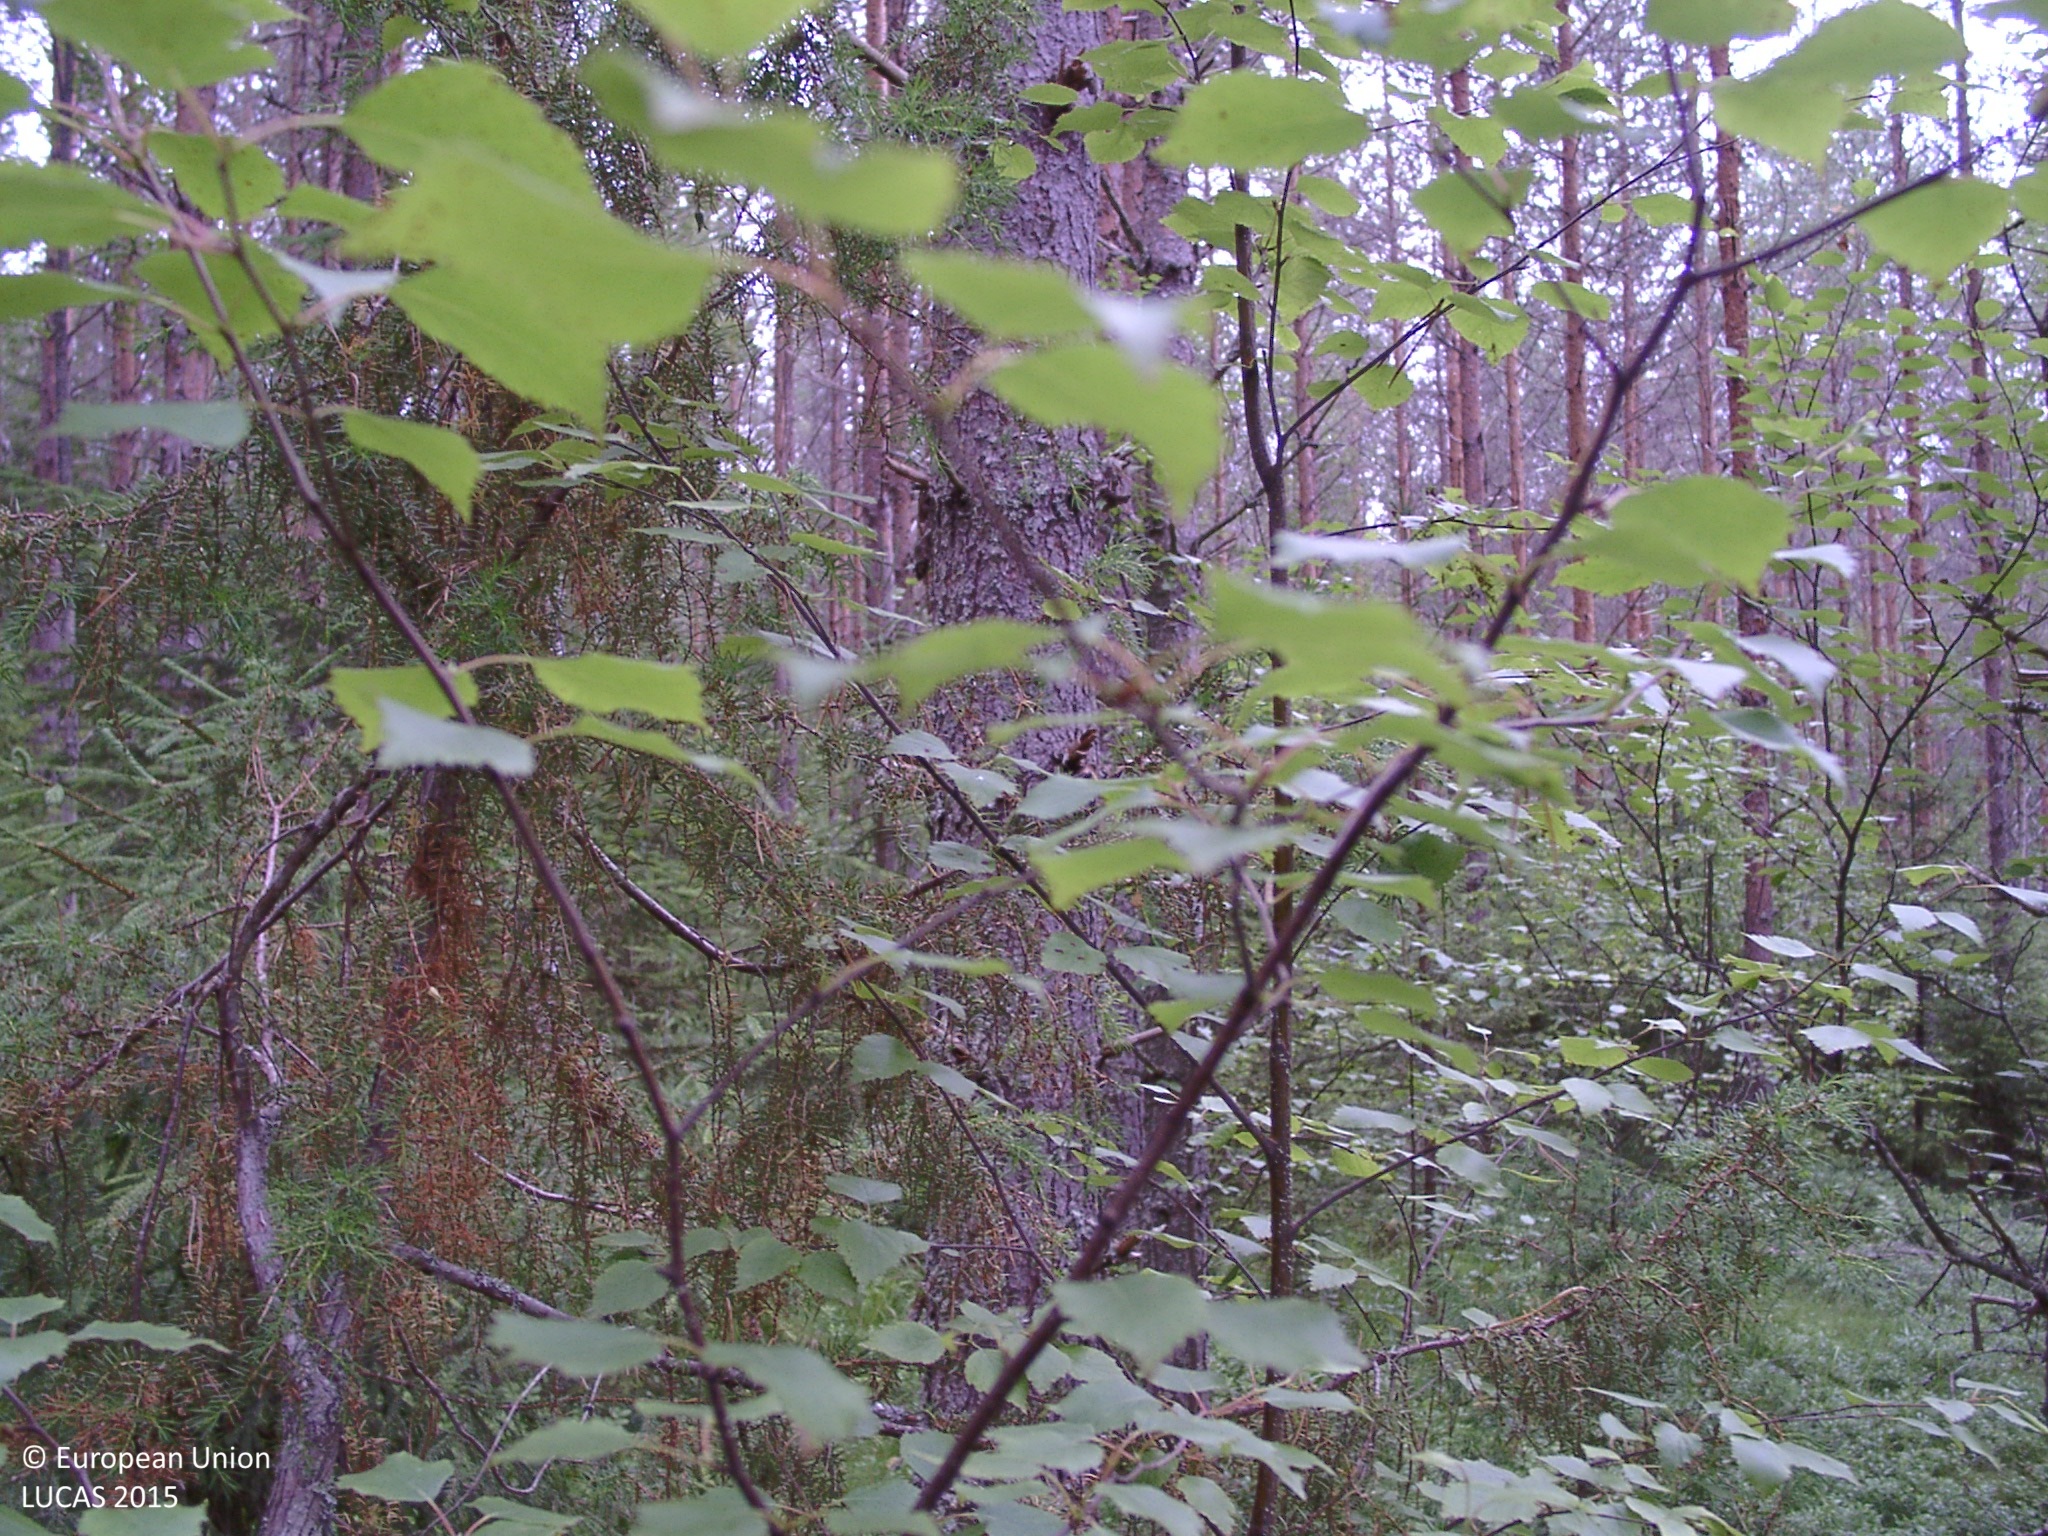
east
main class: Woodland
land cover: Other mixed woodland
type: boreal forest
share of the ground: > 75 %
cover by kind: coniferous forest trees 60 %, broadleaved forest trees 20 %, shrubs 10 %, herbaceous plants 5 %, lichens and mosses 5 %
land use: Forestry
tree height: > 5 m
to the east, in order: Other mixed woodland; Ditches and canals; Other mixed woodland; Grass margins; Groves; Tracks; Groves; Ditches and canals; Other mixed woodland; Ditches and canals
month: July
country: FI
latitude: 62.2652
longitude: 25.3067
